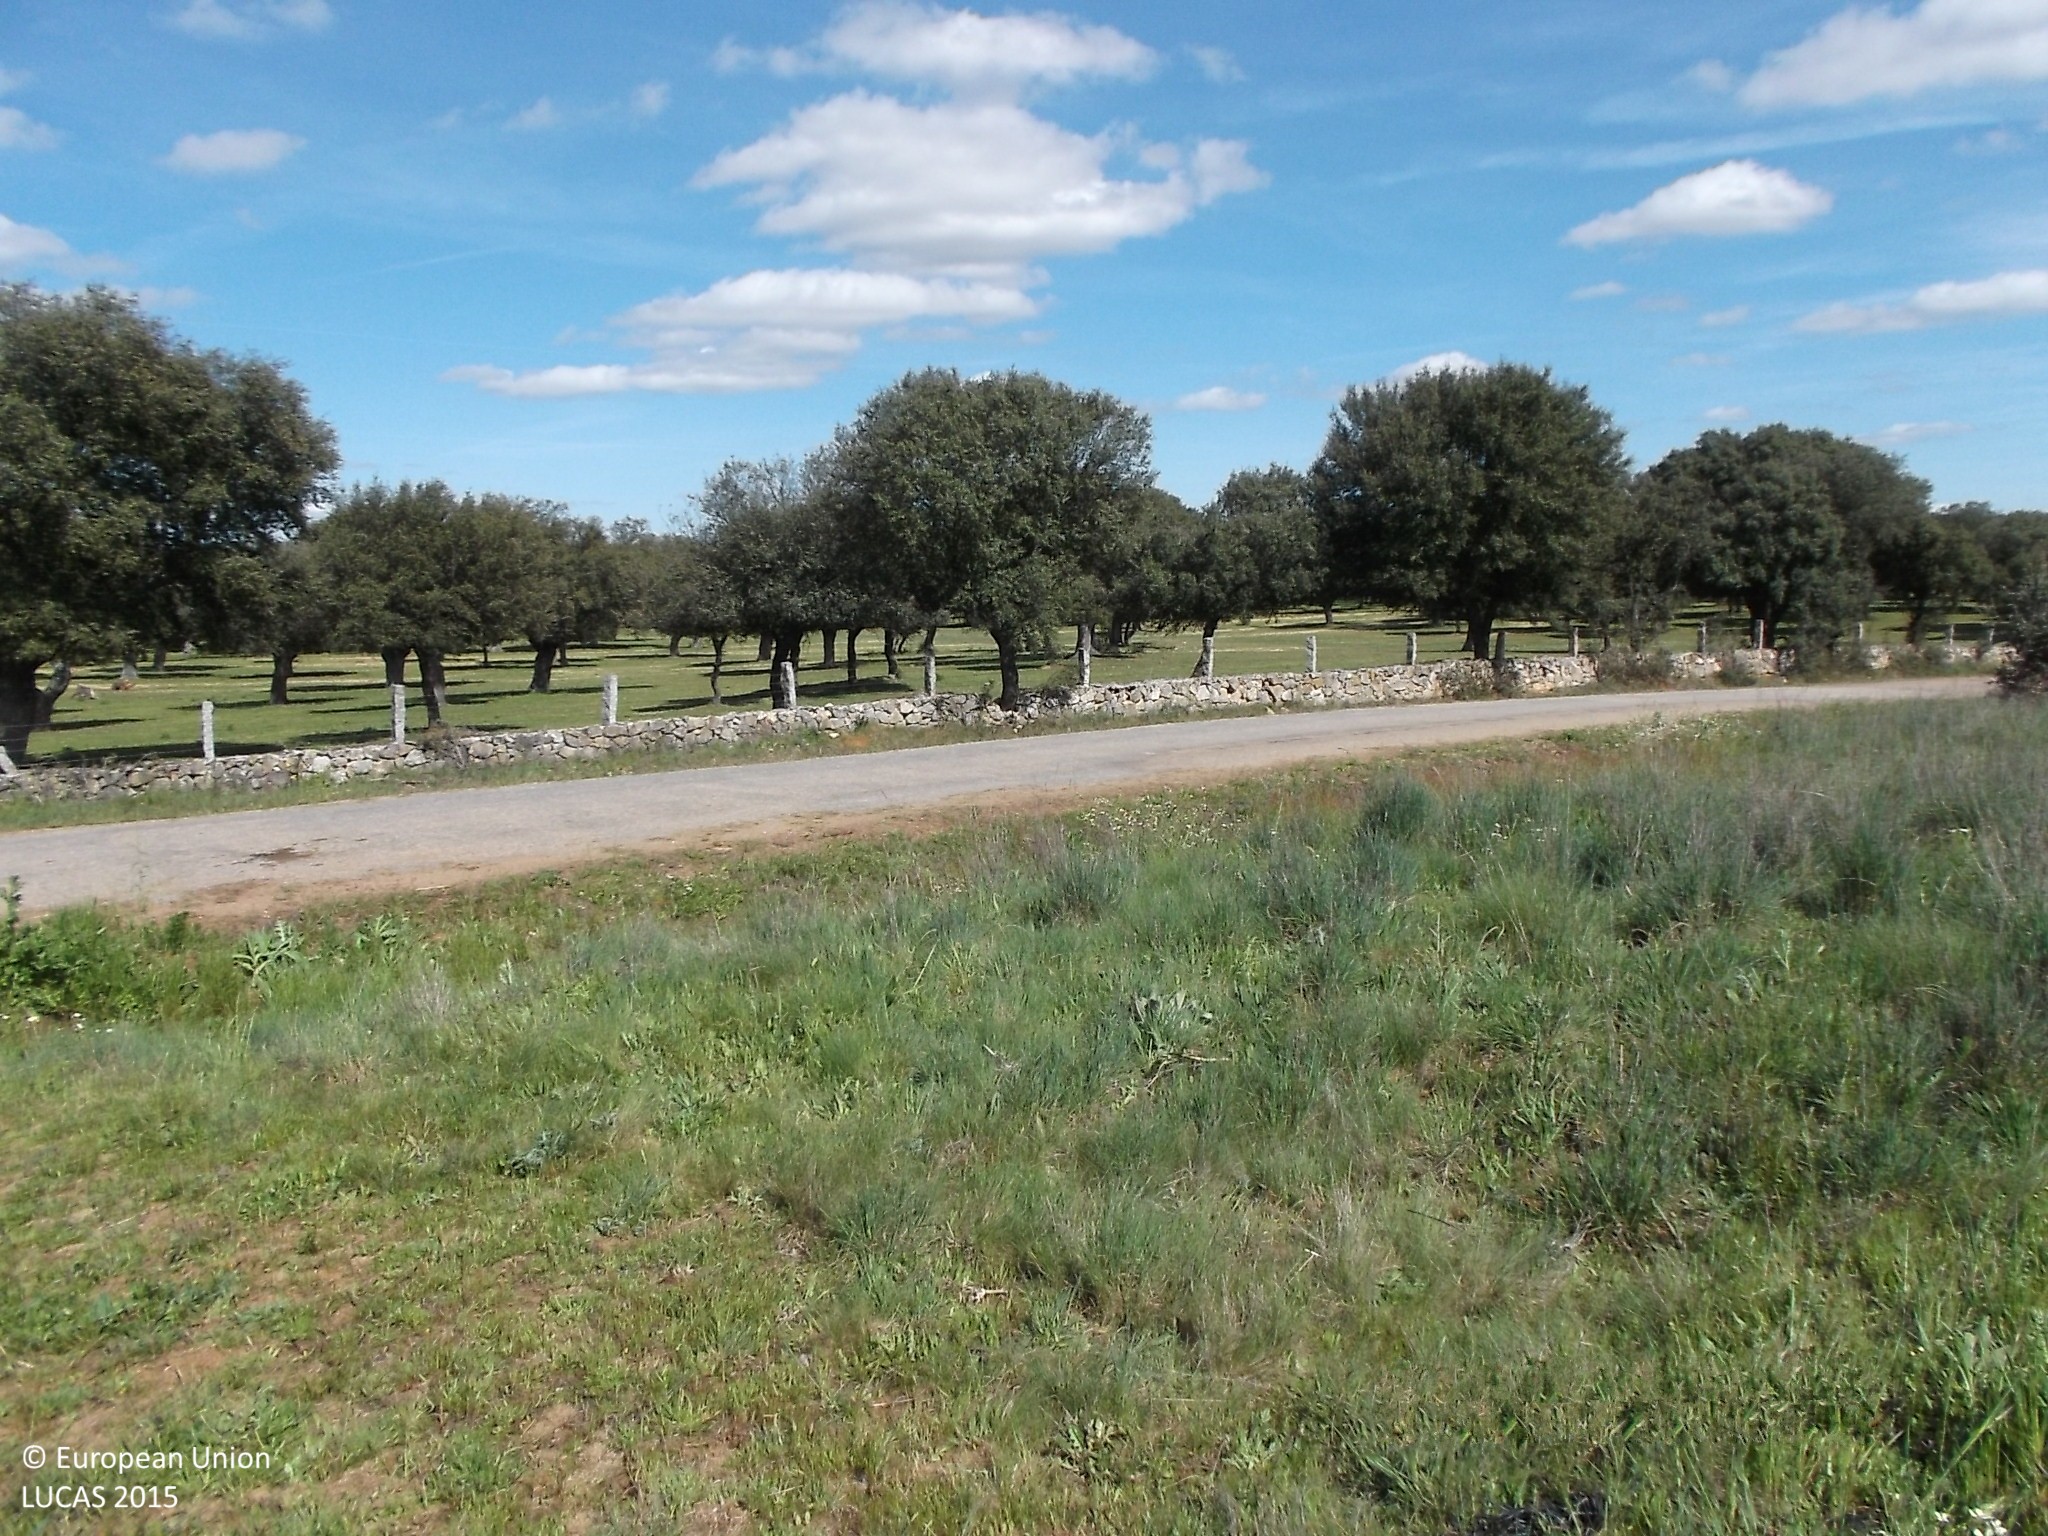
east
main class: Woodland
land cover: Broadleaved woodland
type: broadleaved evergreen forest
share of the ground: 25 - 50 %
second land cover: Grassland without tree/shrub cover
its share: 50 - 75 %
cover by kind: herbaceous plants 70 %, broadleaved forest trees 30 %
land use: Forestry
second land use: Agriculture (excluding fallow land and kitchen gardens)
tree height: > 5 m
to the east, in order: Broadleaved woodland; Grassland without tree/shrub cover; Dry stone walls; Grassland without tree/shrub cover; Paved roads, cycling and walking lanes; Grass margins; Dry stone walls; Grassland without tree/shrub cover; Broadleaved woodland
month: April
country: ES
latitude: 40.9374
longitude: -5.9627
